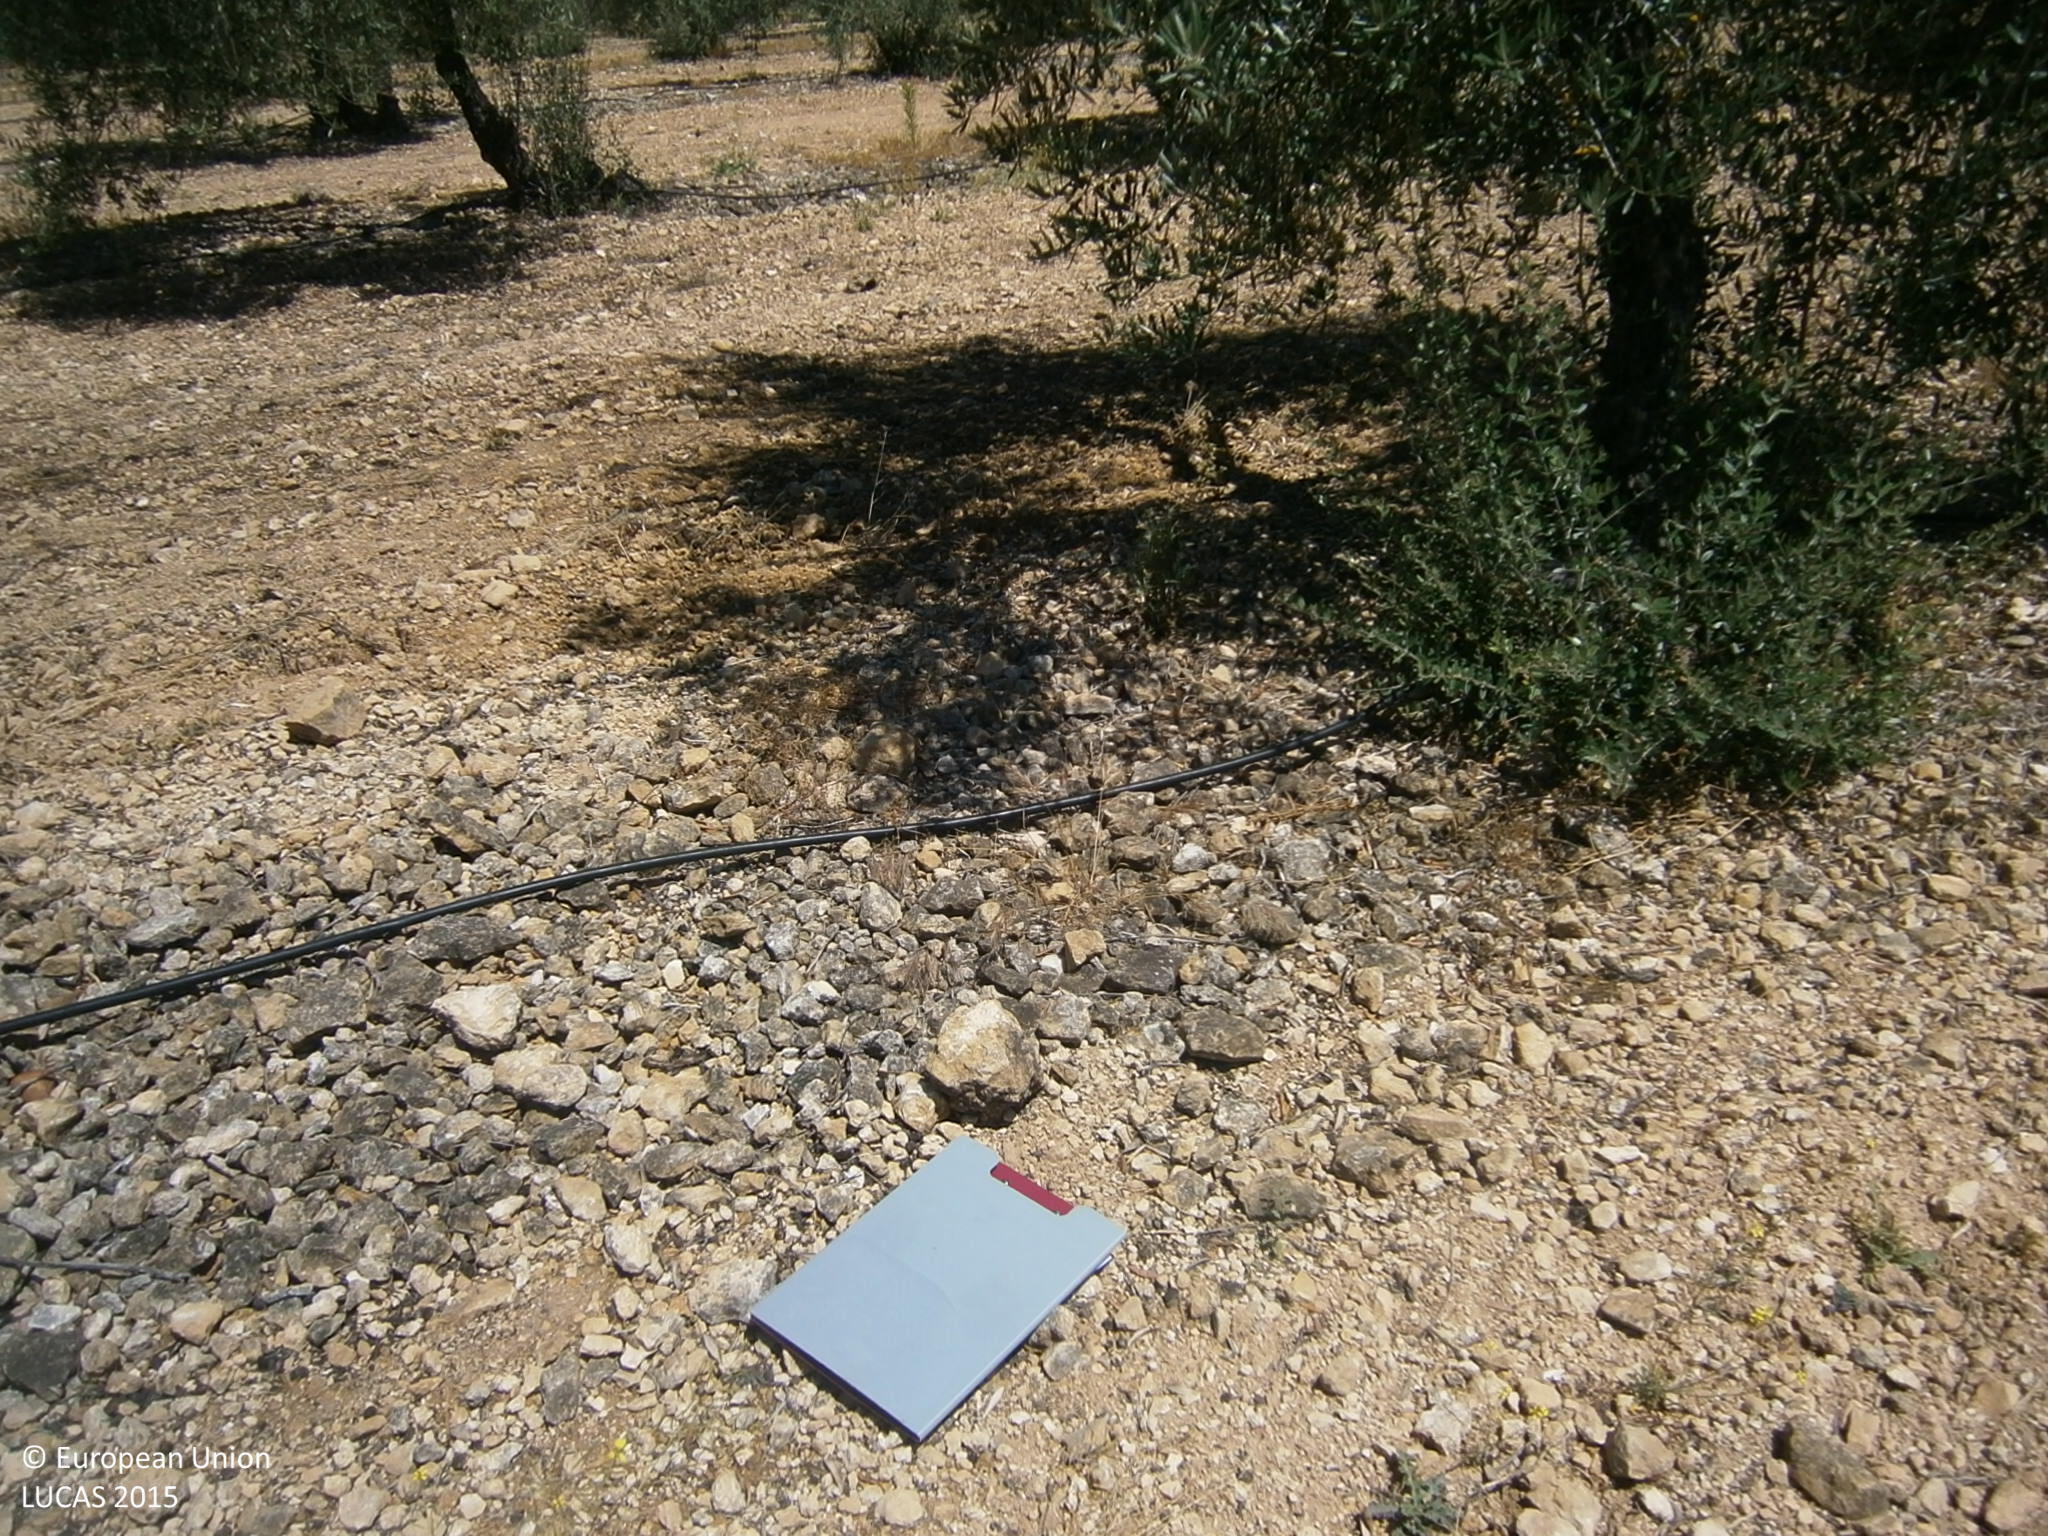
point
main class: Cropland
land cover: Olive groves
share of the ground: 25 - 50 %
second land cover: Other bare soil
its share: > 75 %
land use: Agriculture (excluding fallow land and kitchen gardens)
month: June
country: ES
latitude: 38.7488
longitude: -6.5000
